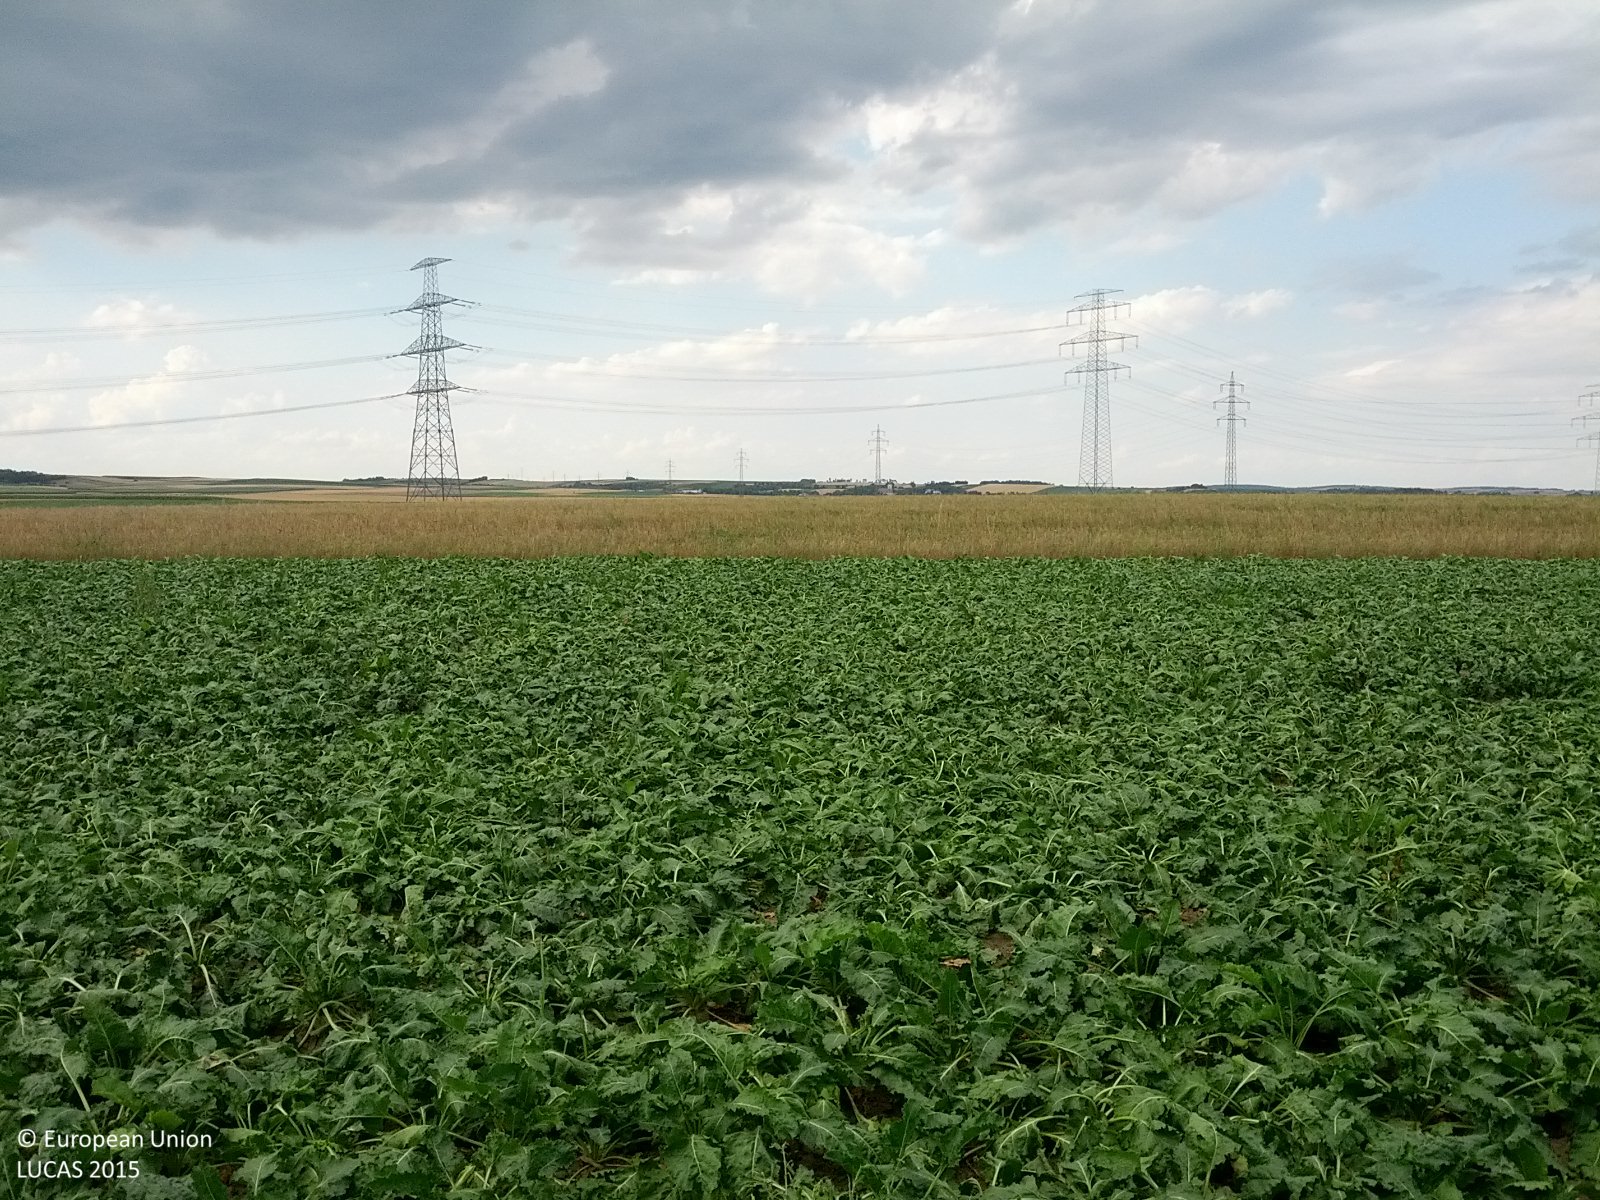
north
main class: Cropland
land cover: Sugar beet
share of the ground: > 75 %
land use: Agriculture (excluding fallow land and kitchen gardens)
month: July
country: AT
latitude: 48.4141
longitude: 16.1249
